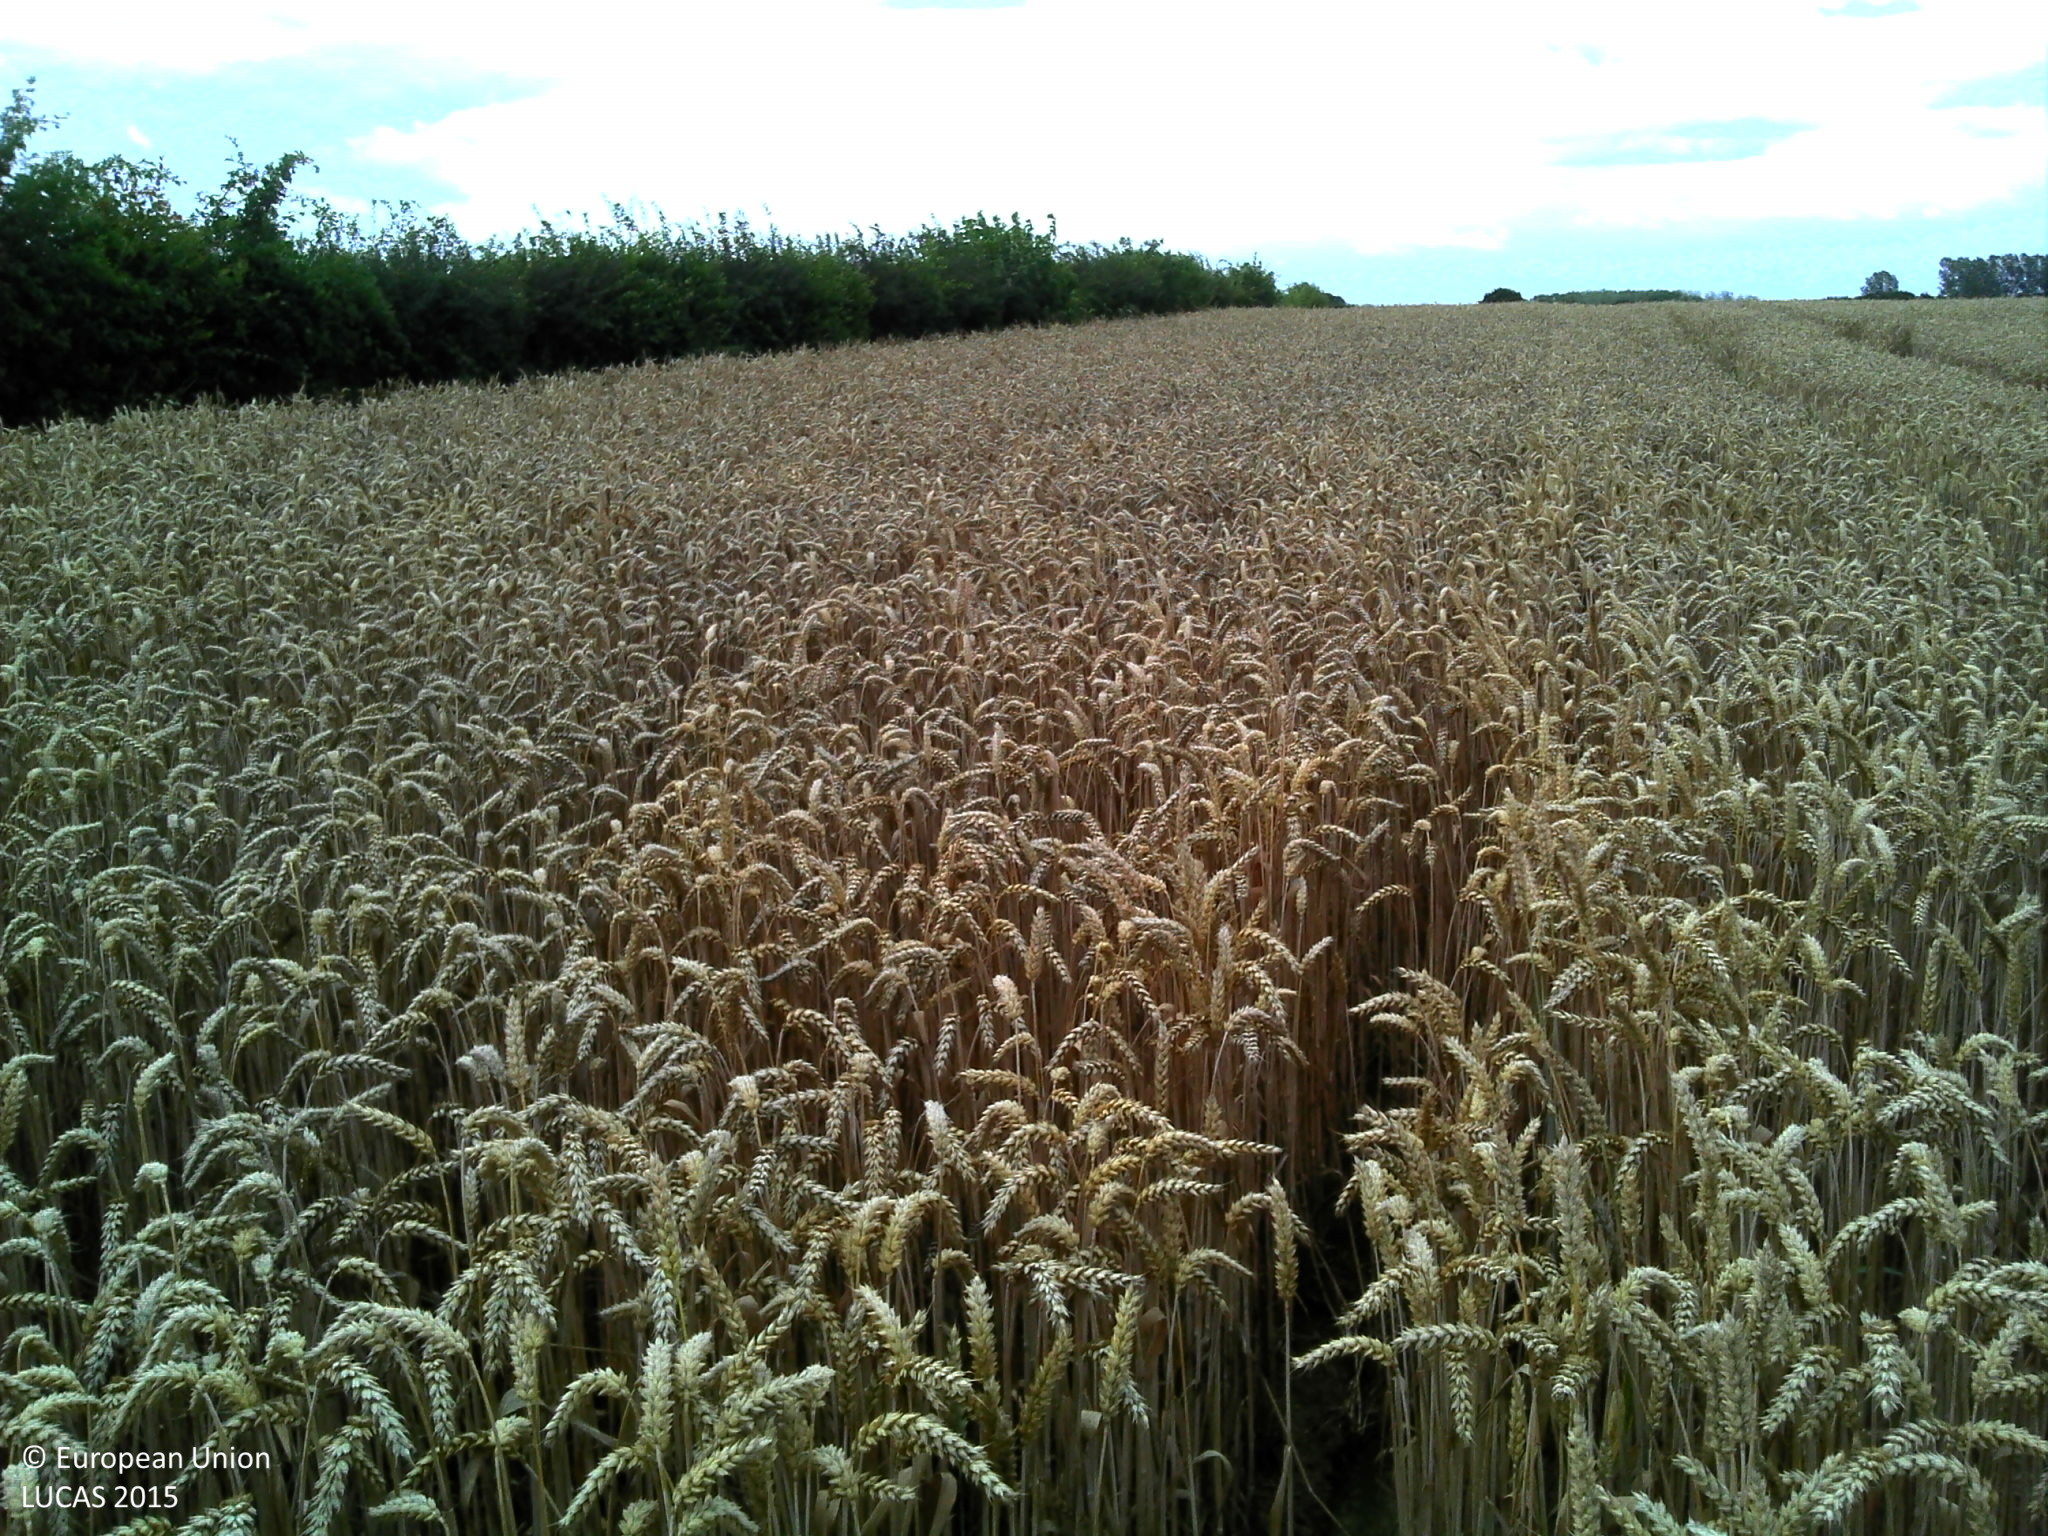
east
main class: Cropland
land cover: Common wheat
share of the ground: > 75 %
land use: Agriculture (excluding fallow land and kitchen gardens)
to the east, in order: Common wheat; Abandoned hedges; Grass margins; Paved roads, cycling and walking lanes; Grass margins; Abandoned hedges; Sugar beet
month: July
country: FR
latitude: 50.1322
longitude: 3.6277
